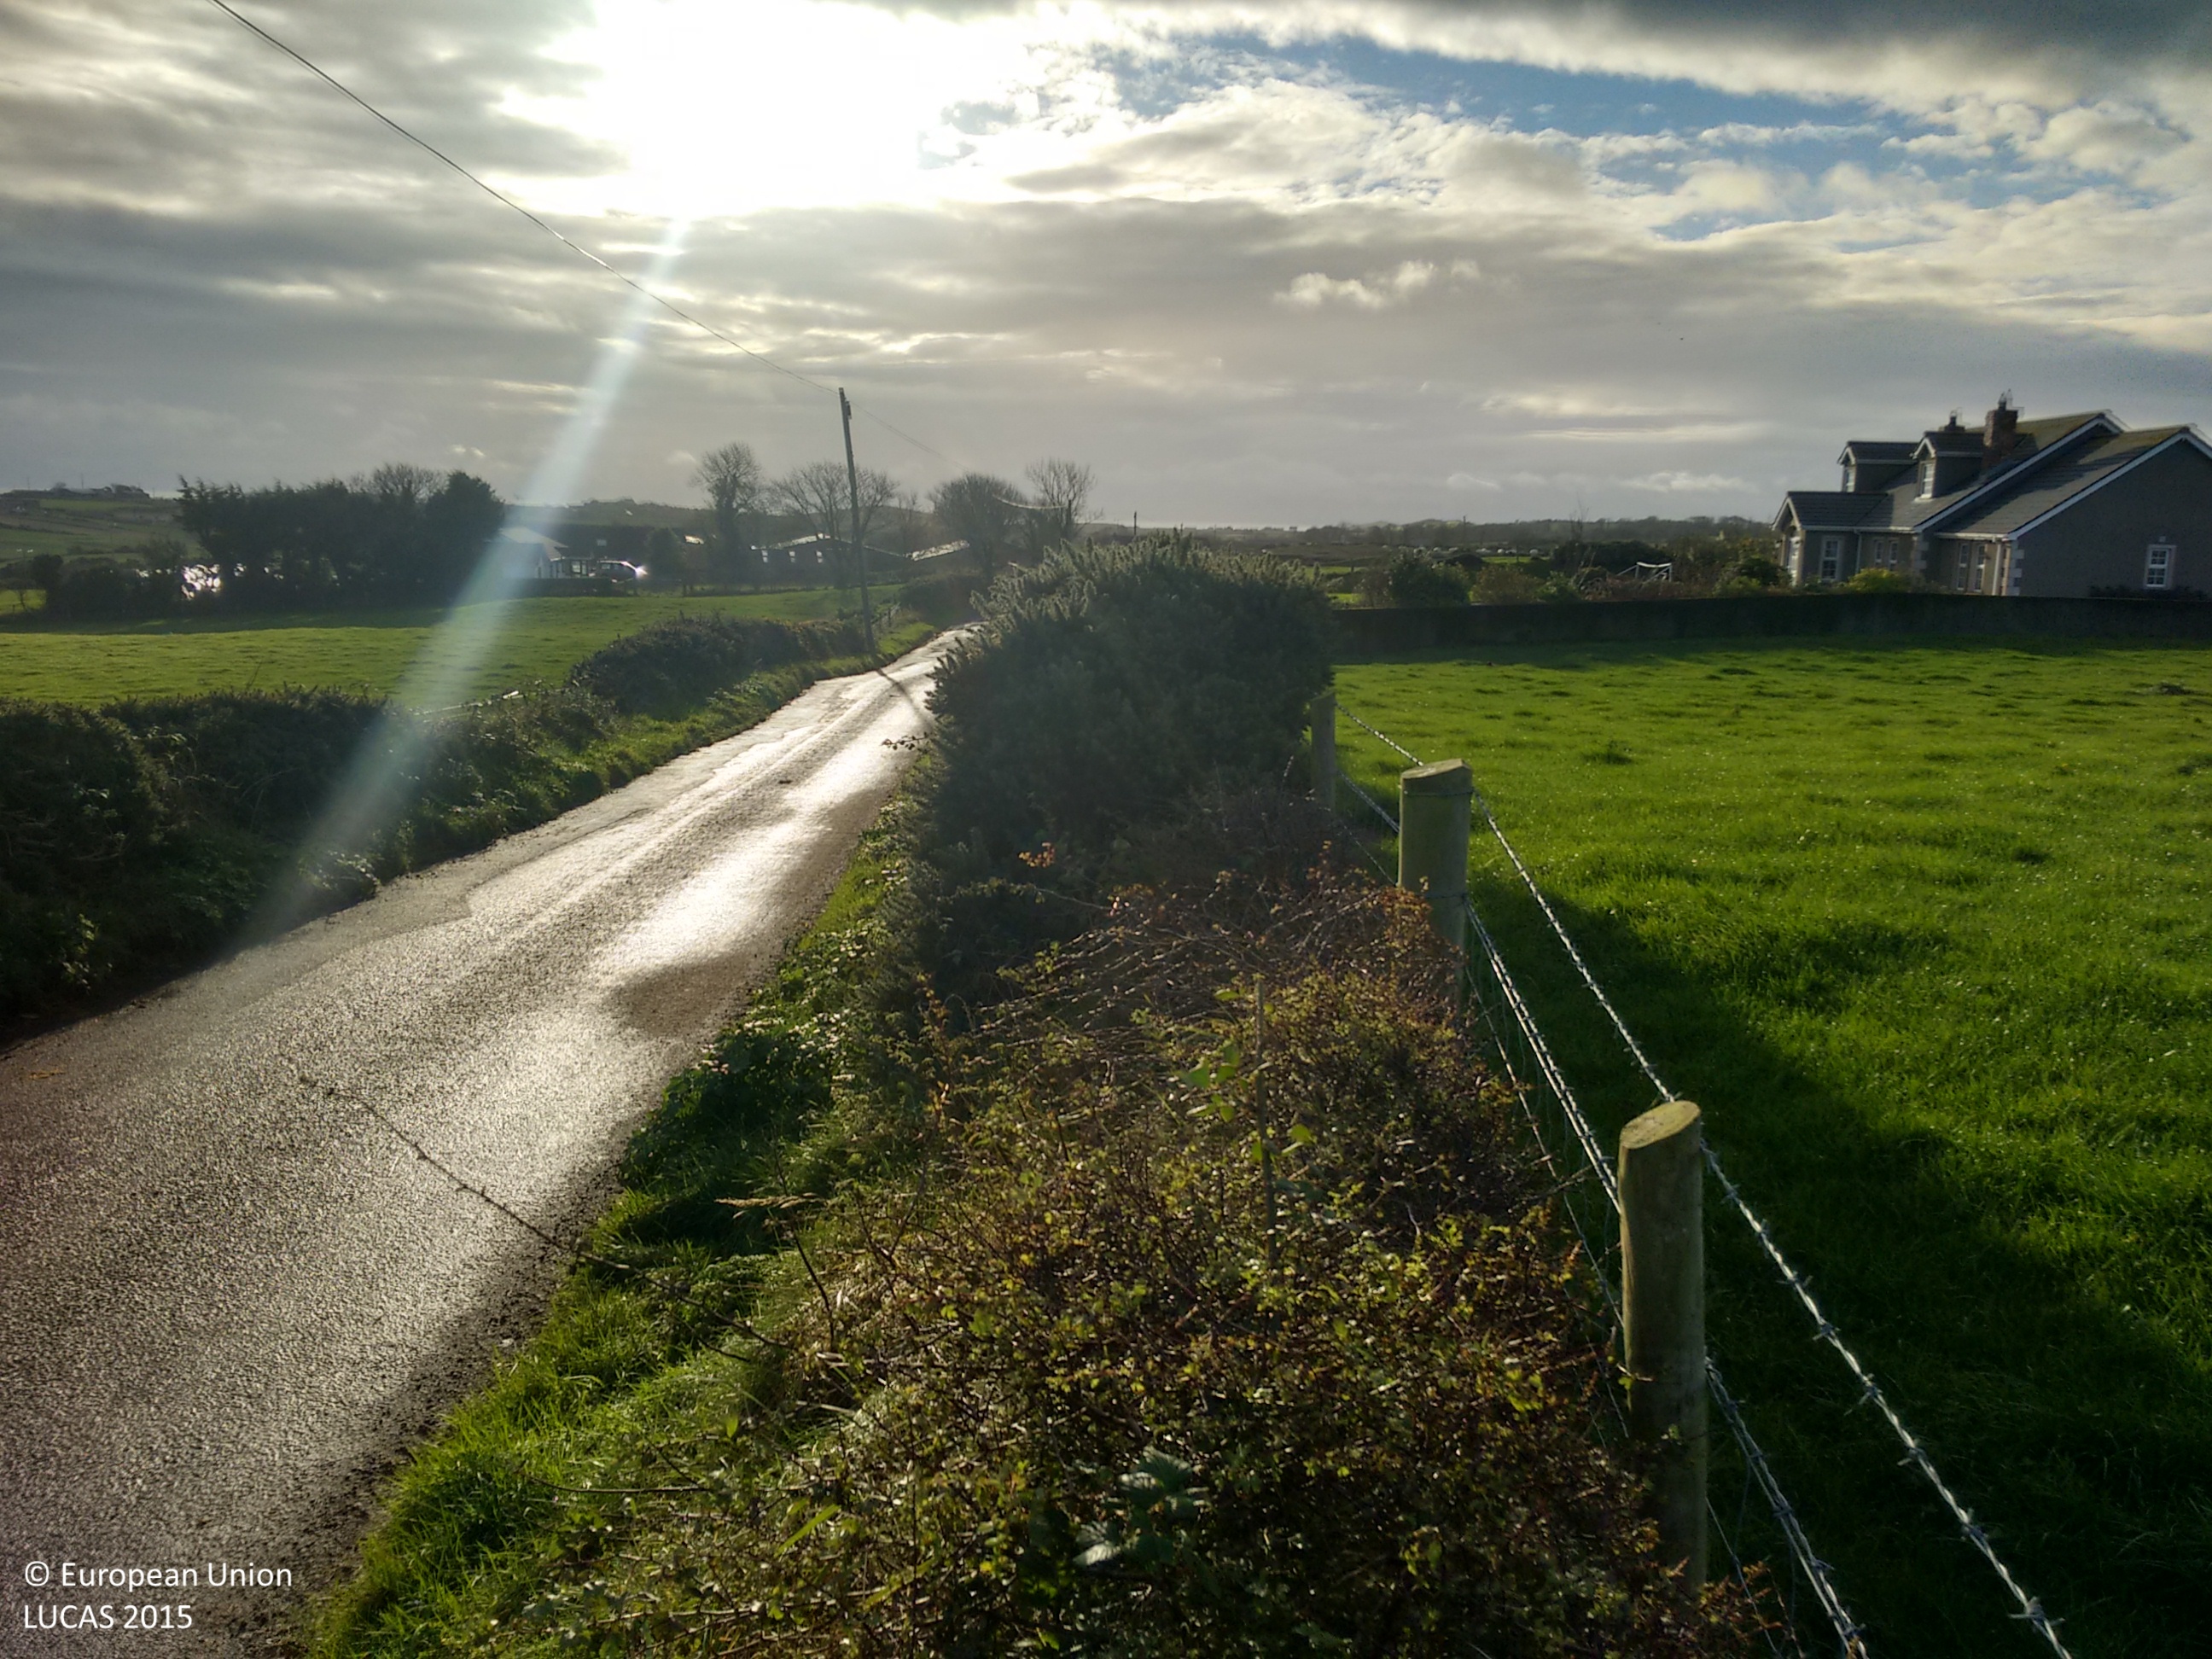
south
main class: Grassland
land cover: Grassland without tree/shrub cover
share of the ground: > 75 %
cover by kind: herbaceous plants 100 %
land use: Agriculture (excluding fallow land and kitchen gardens)
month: November
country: GB
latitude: 54.4132
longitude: -5.4898
